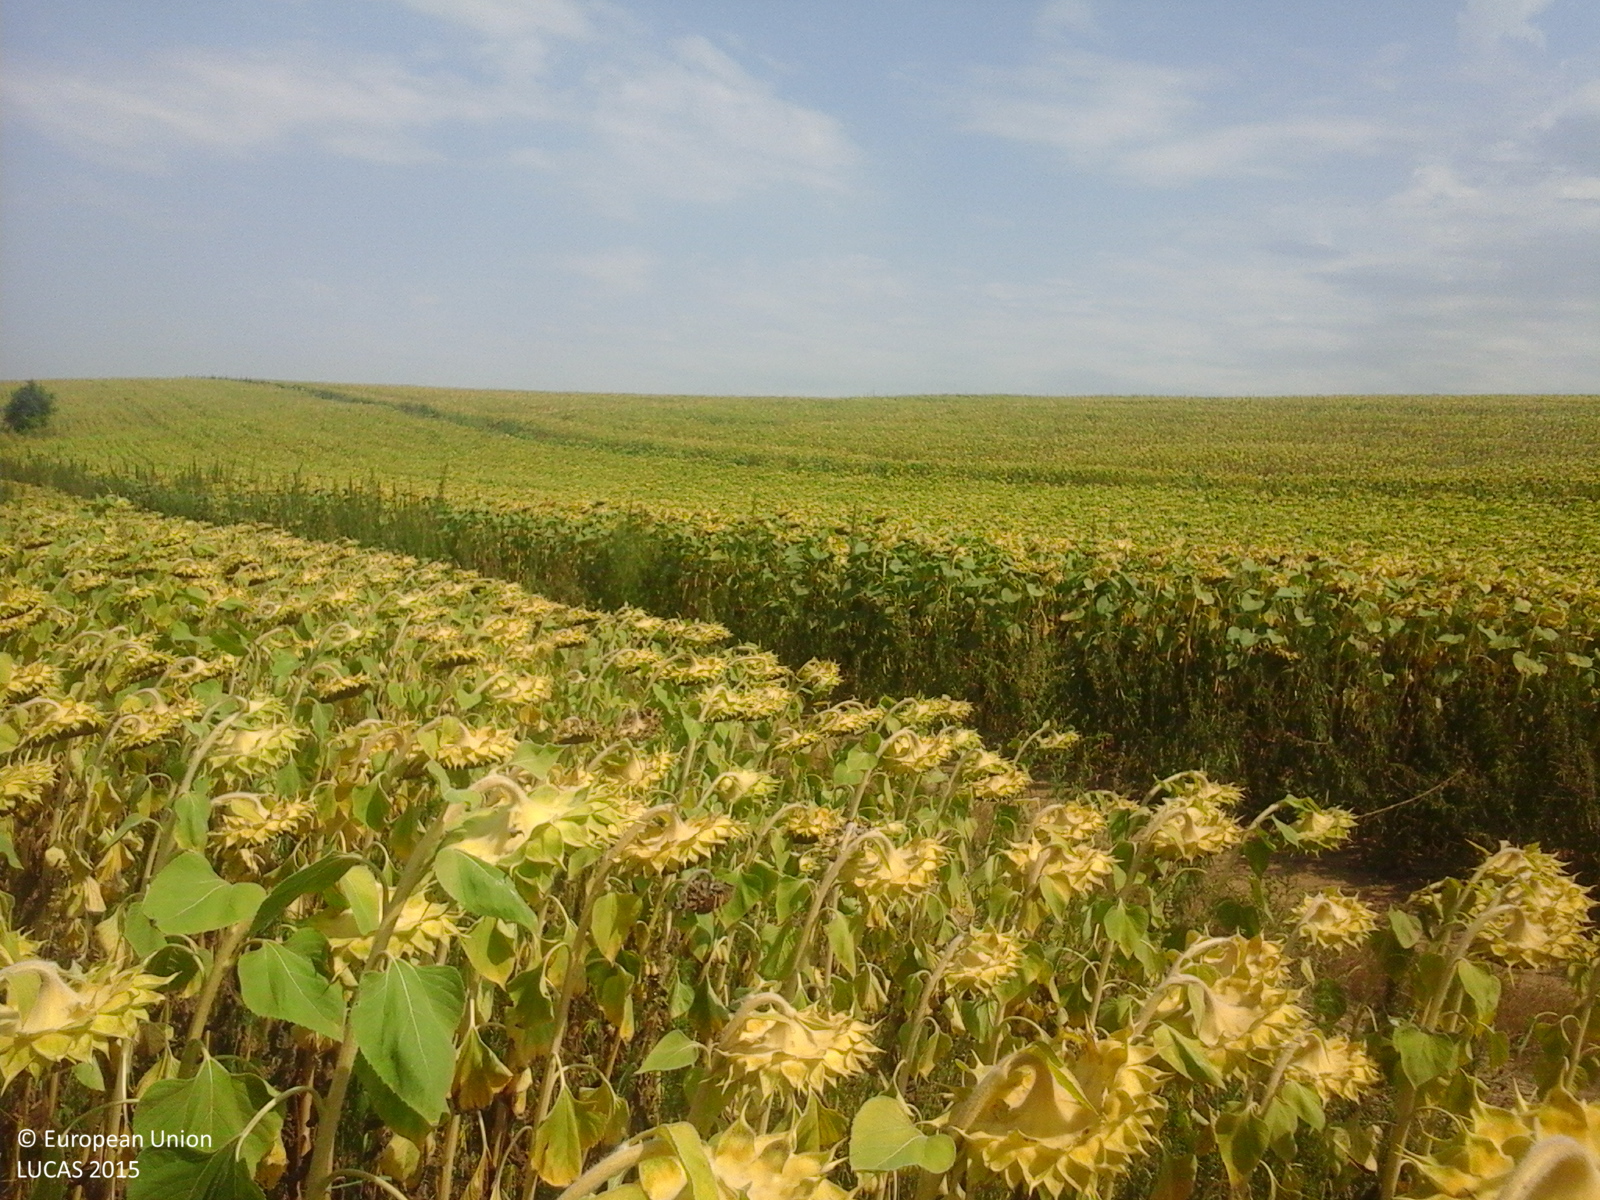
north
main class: Cropland
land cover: Sunflower
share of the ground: > 75 %
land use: Agriculture (excluding fallow land and kitchen gardens)
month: August
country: RO
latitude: 44.0005
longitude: 27.7664
